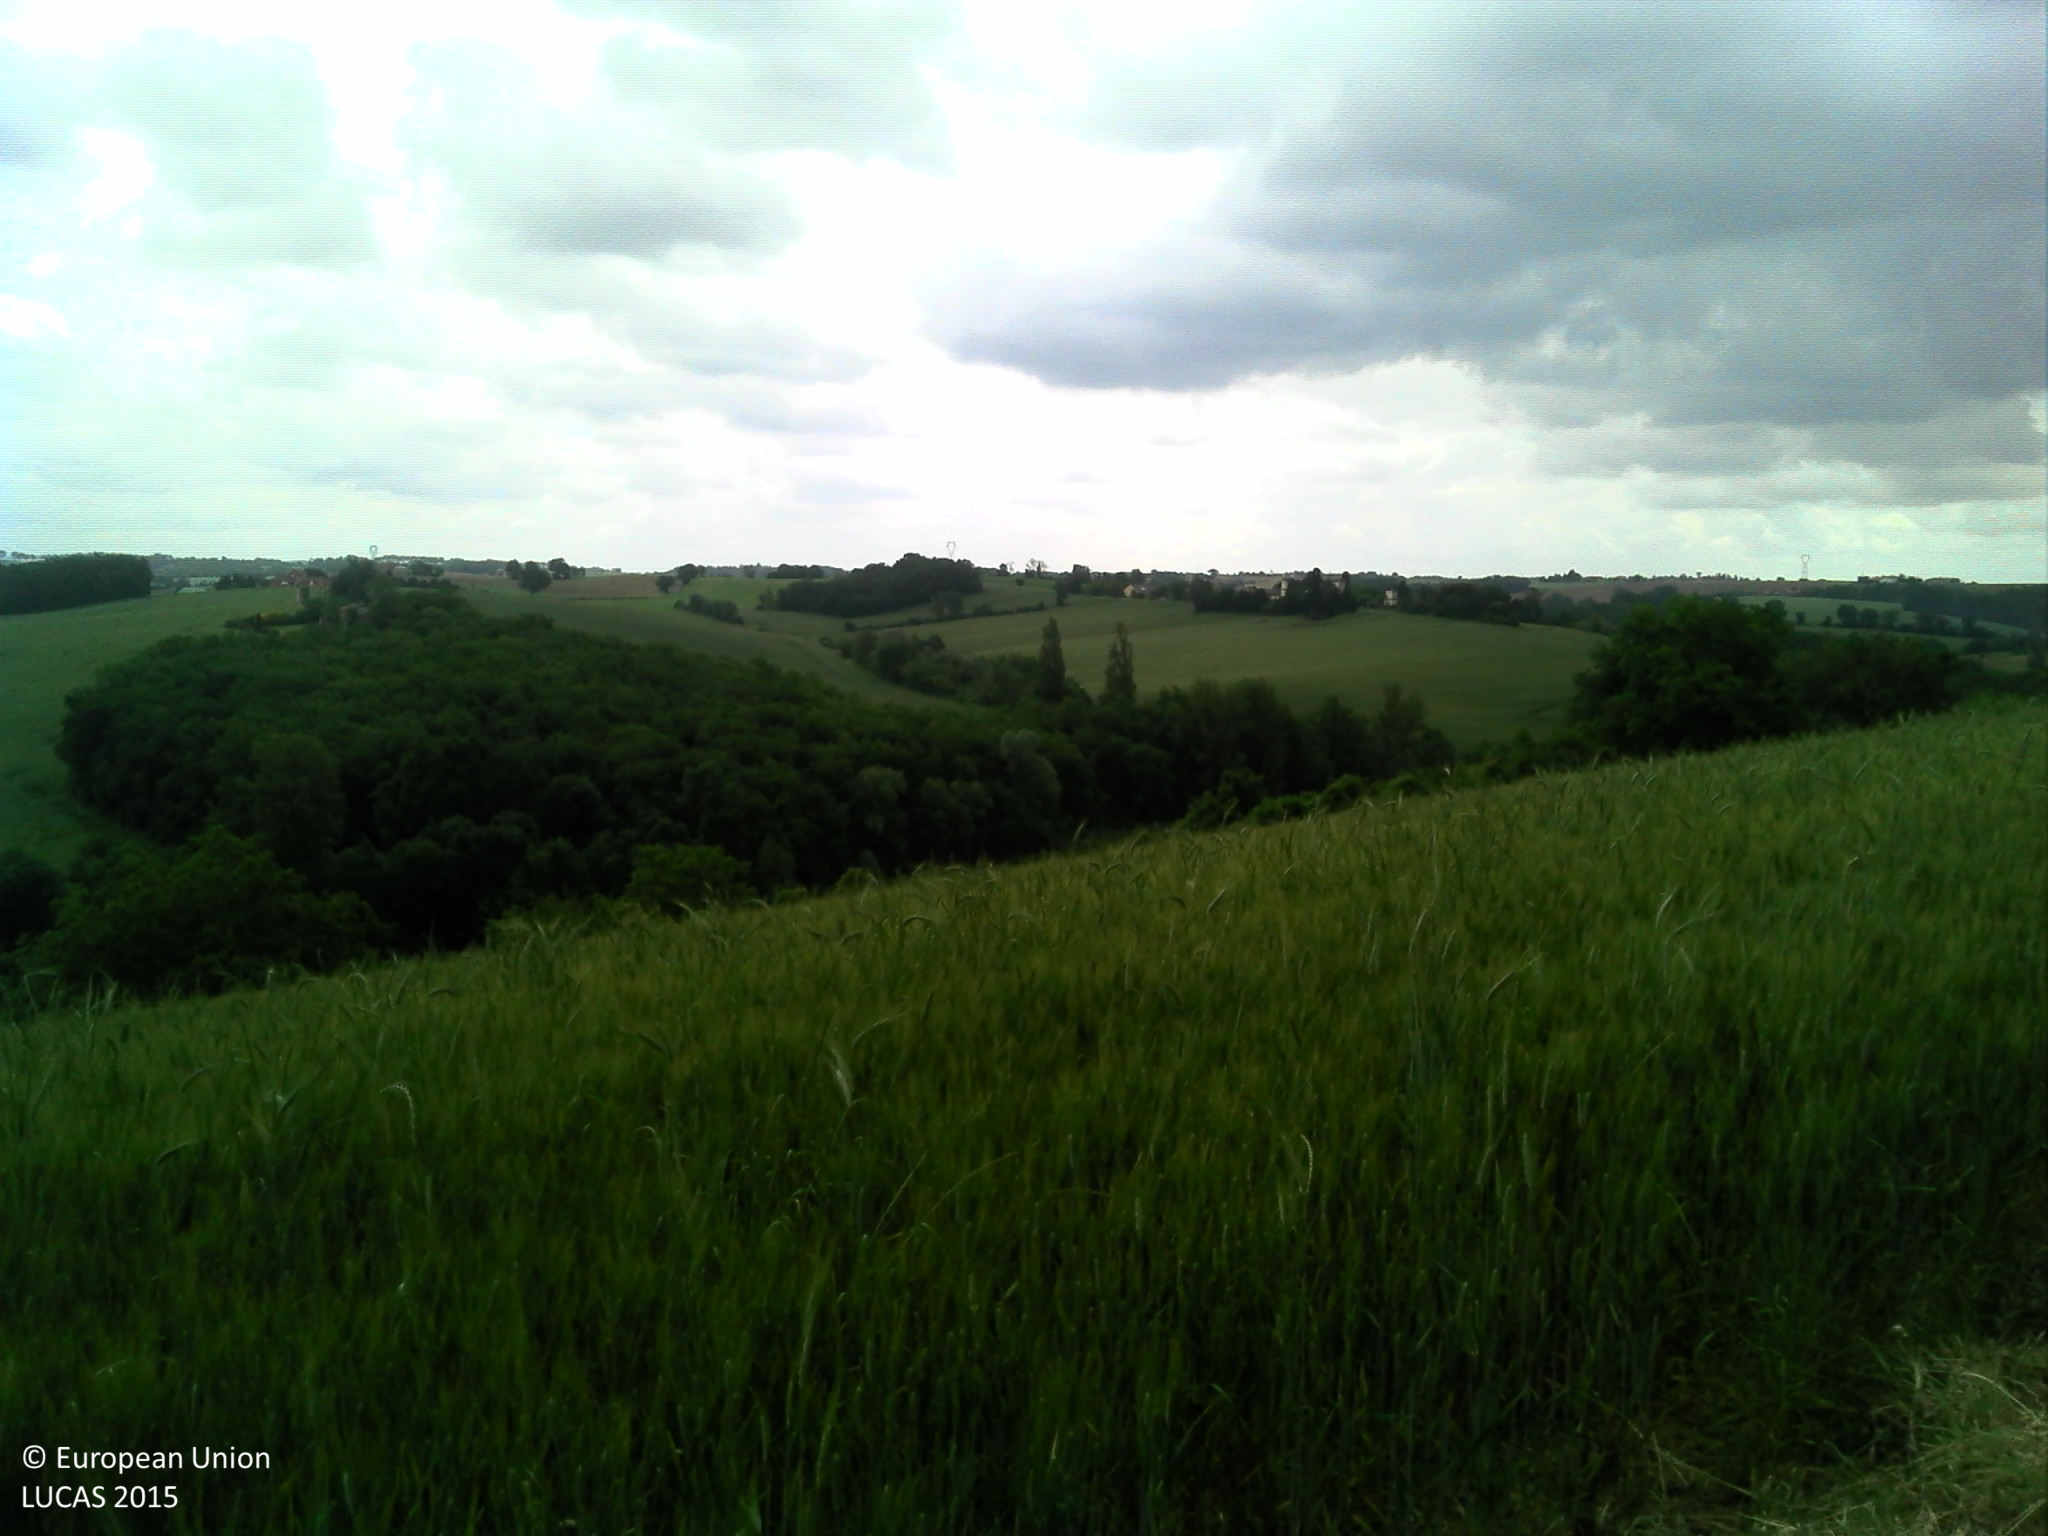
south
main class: Grassland
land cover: Grassland with sparse tree/shrub cover
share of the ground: > 75 %
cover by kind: herbaceous plants 95 %, broadleaved forest trees 5 %
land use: Agriculture (excluding fallow land and kitchen gardens)
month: May
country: FR
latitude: 43.7115
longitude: 1.7252
